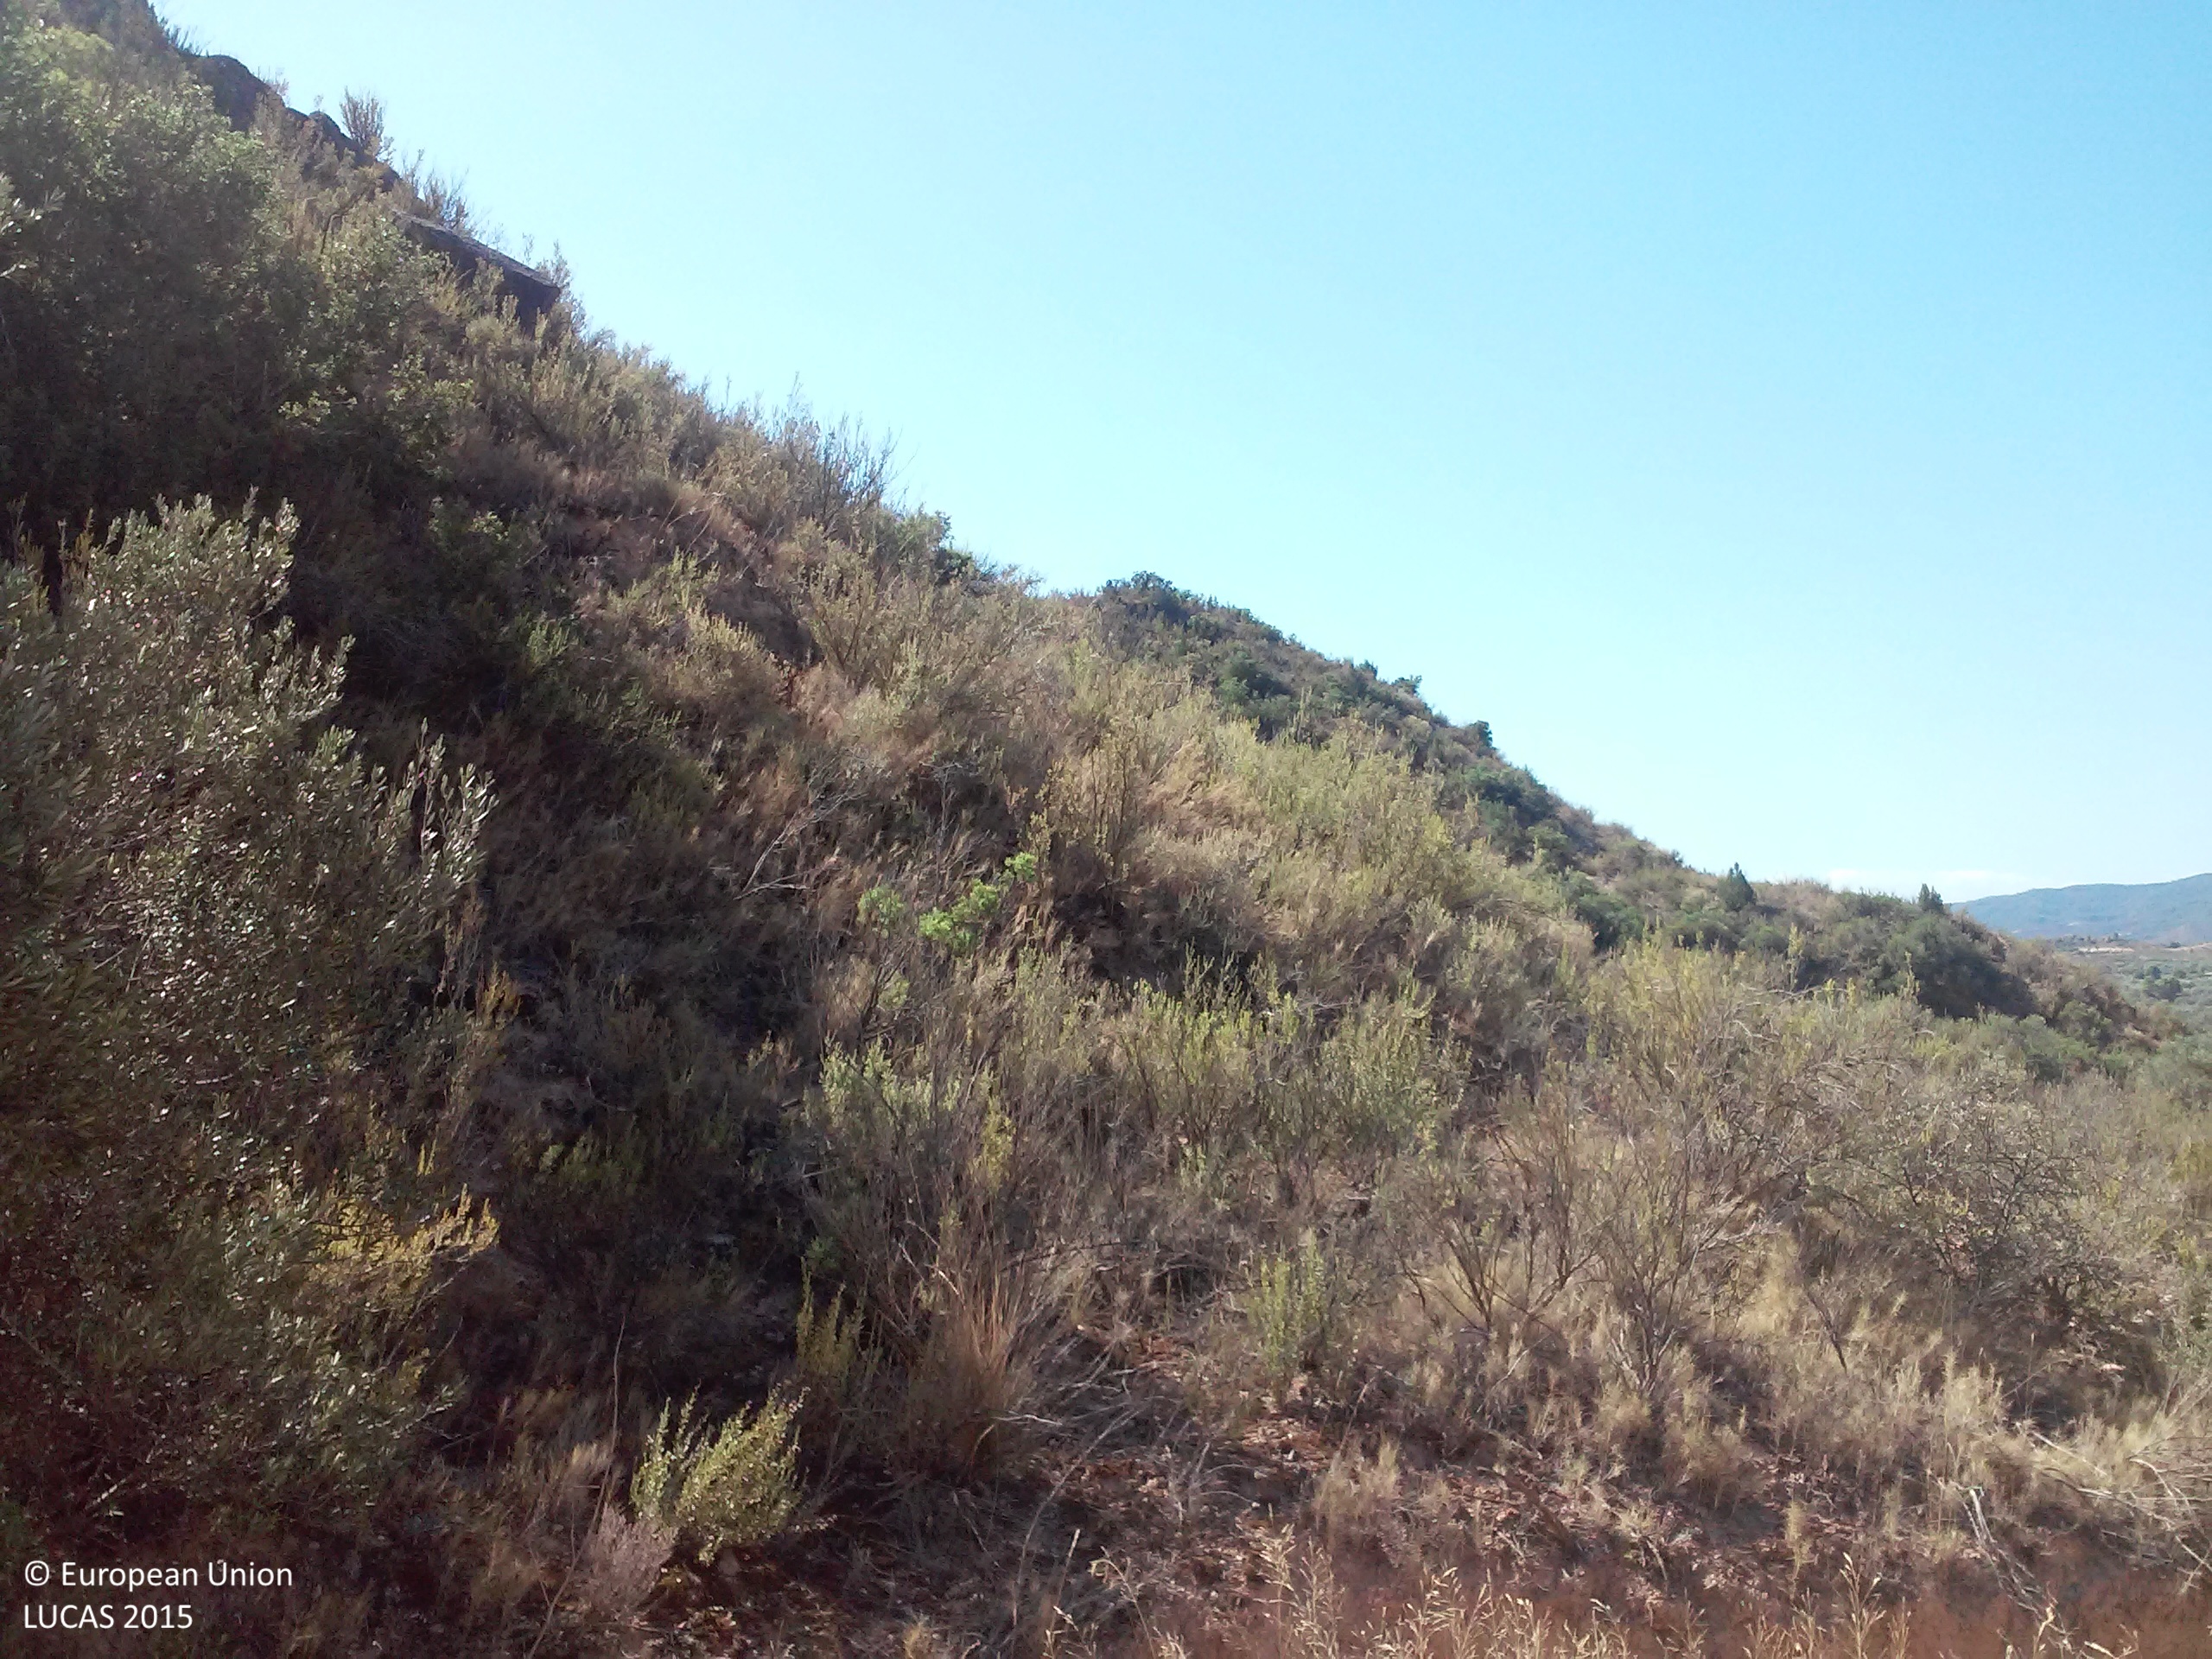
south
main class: Cropland
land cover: Olive groves
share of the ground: 10 - 25 %
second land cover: Spontaneously vegetated surfaces
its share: > 75 %
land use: Agriculture (excluding fallow land and kitchen gardens)
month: August
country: ES
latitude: 41.2613
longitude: 0.5011
